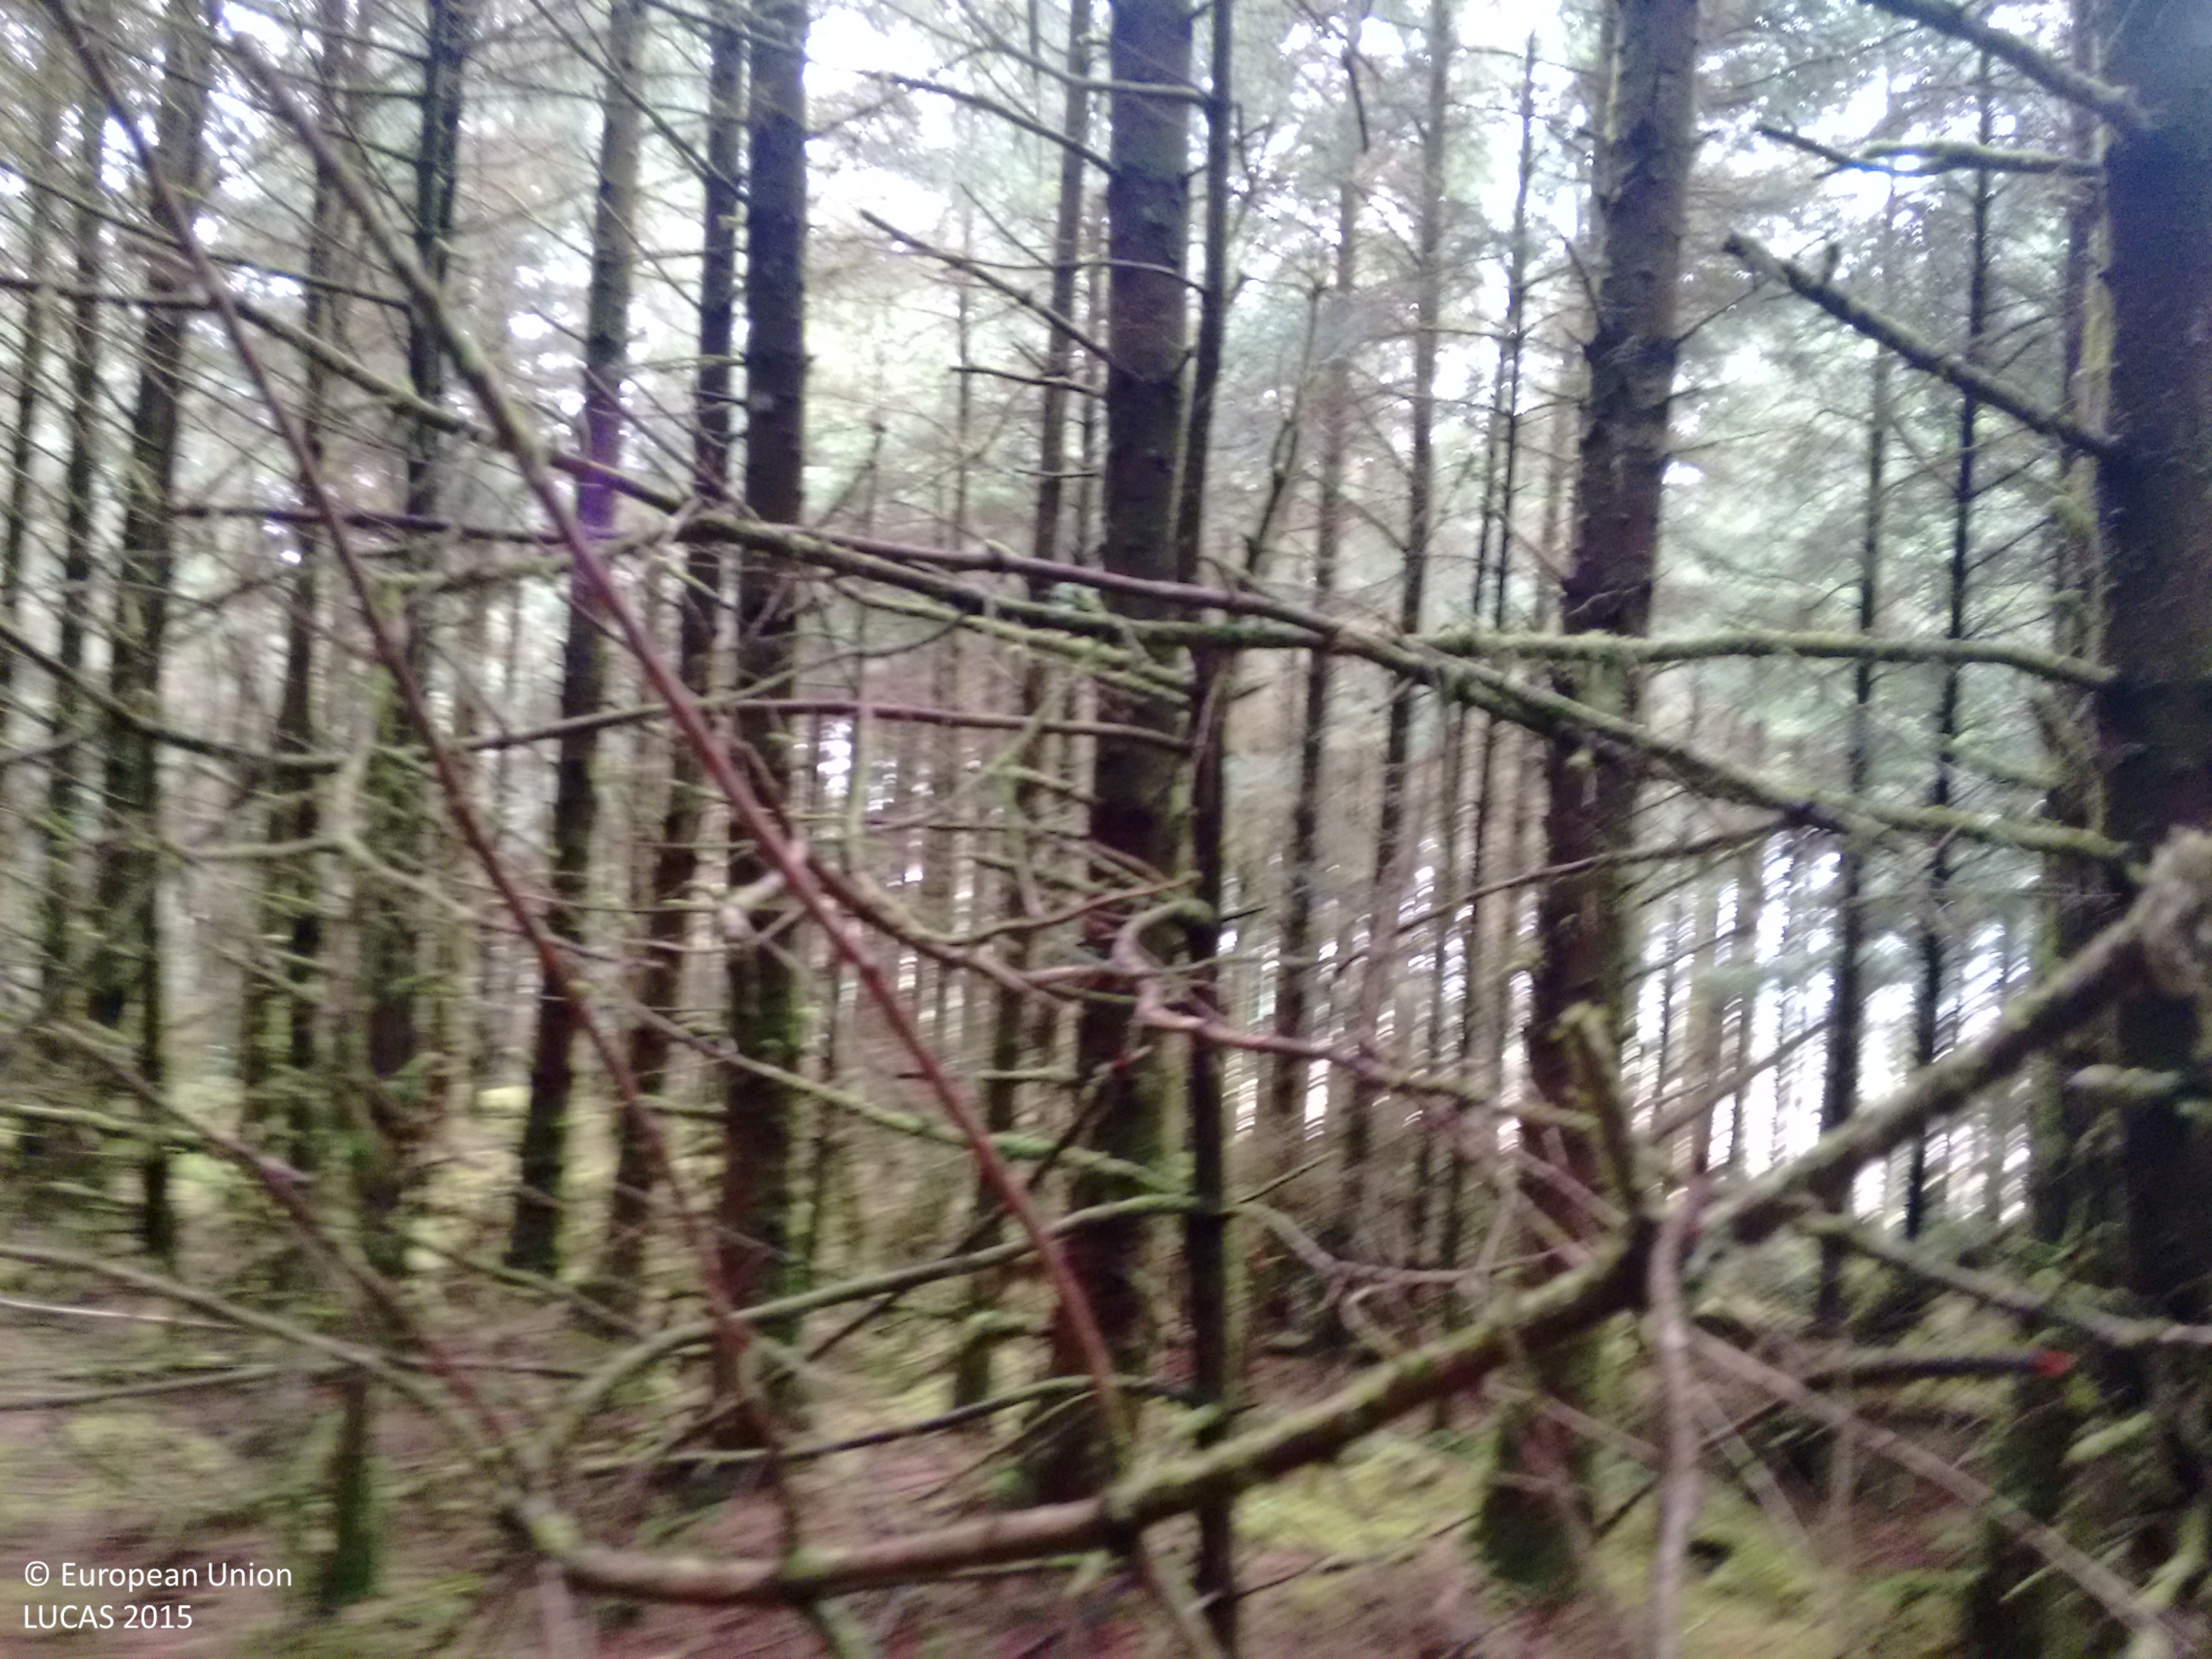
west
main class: Woodland
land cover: Spruce dominated coniferous woodland
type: exotic forest
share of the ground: > 75 %
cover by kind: coniferous forest trees 100 %
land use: Forestry
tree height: > 5 m
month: August
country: IE
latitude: 51.9092
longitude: -10.0093
